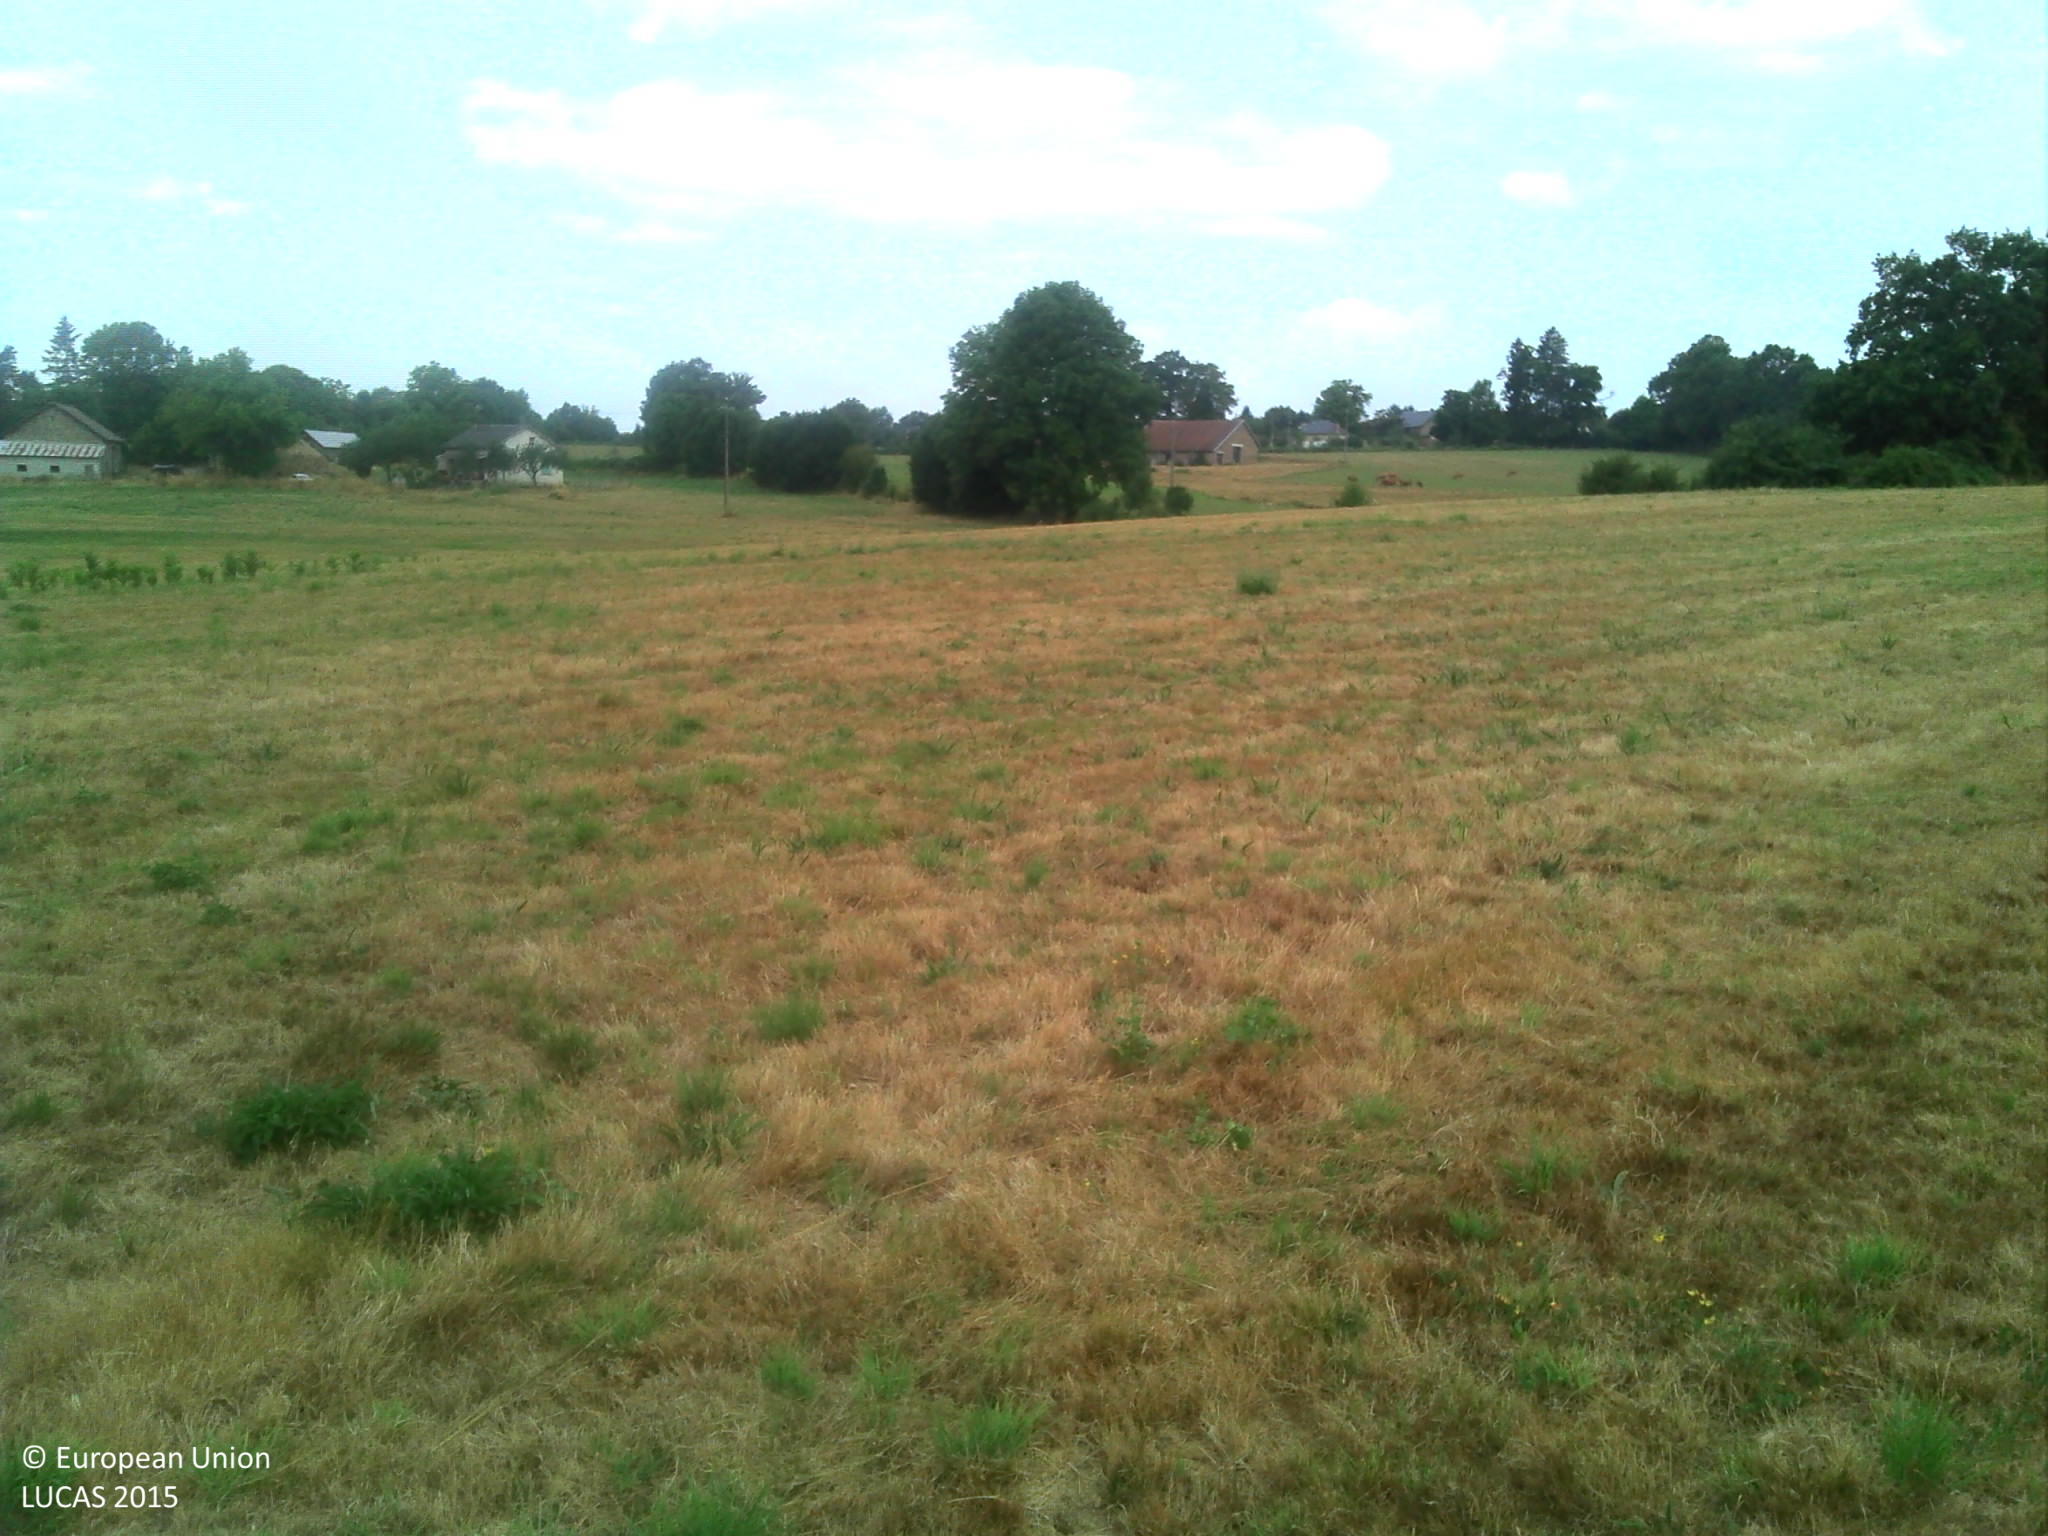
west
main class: Grassland
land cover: Grassland without tree/shrub cover
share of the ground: > 75 %
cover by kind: herbaceous plants 95 %, shrubs 5 %
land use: Agriculture (excluding fallow land and kitchen gardens)
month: July
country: FR
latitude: 45.3966
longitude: 1.4992
